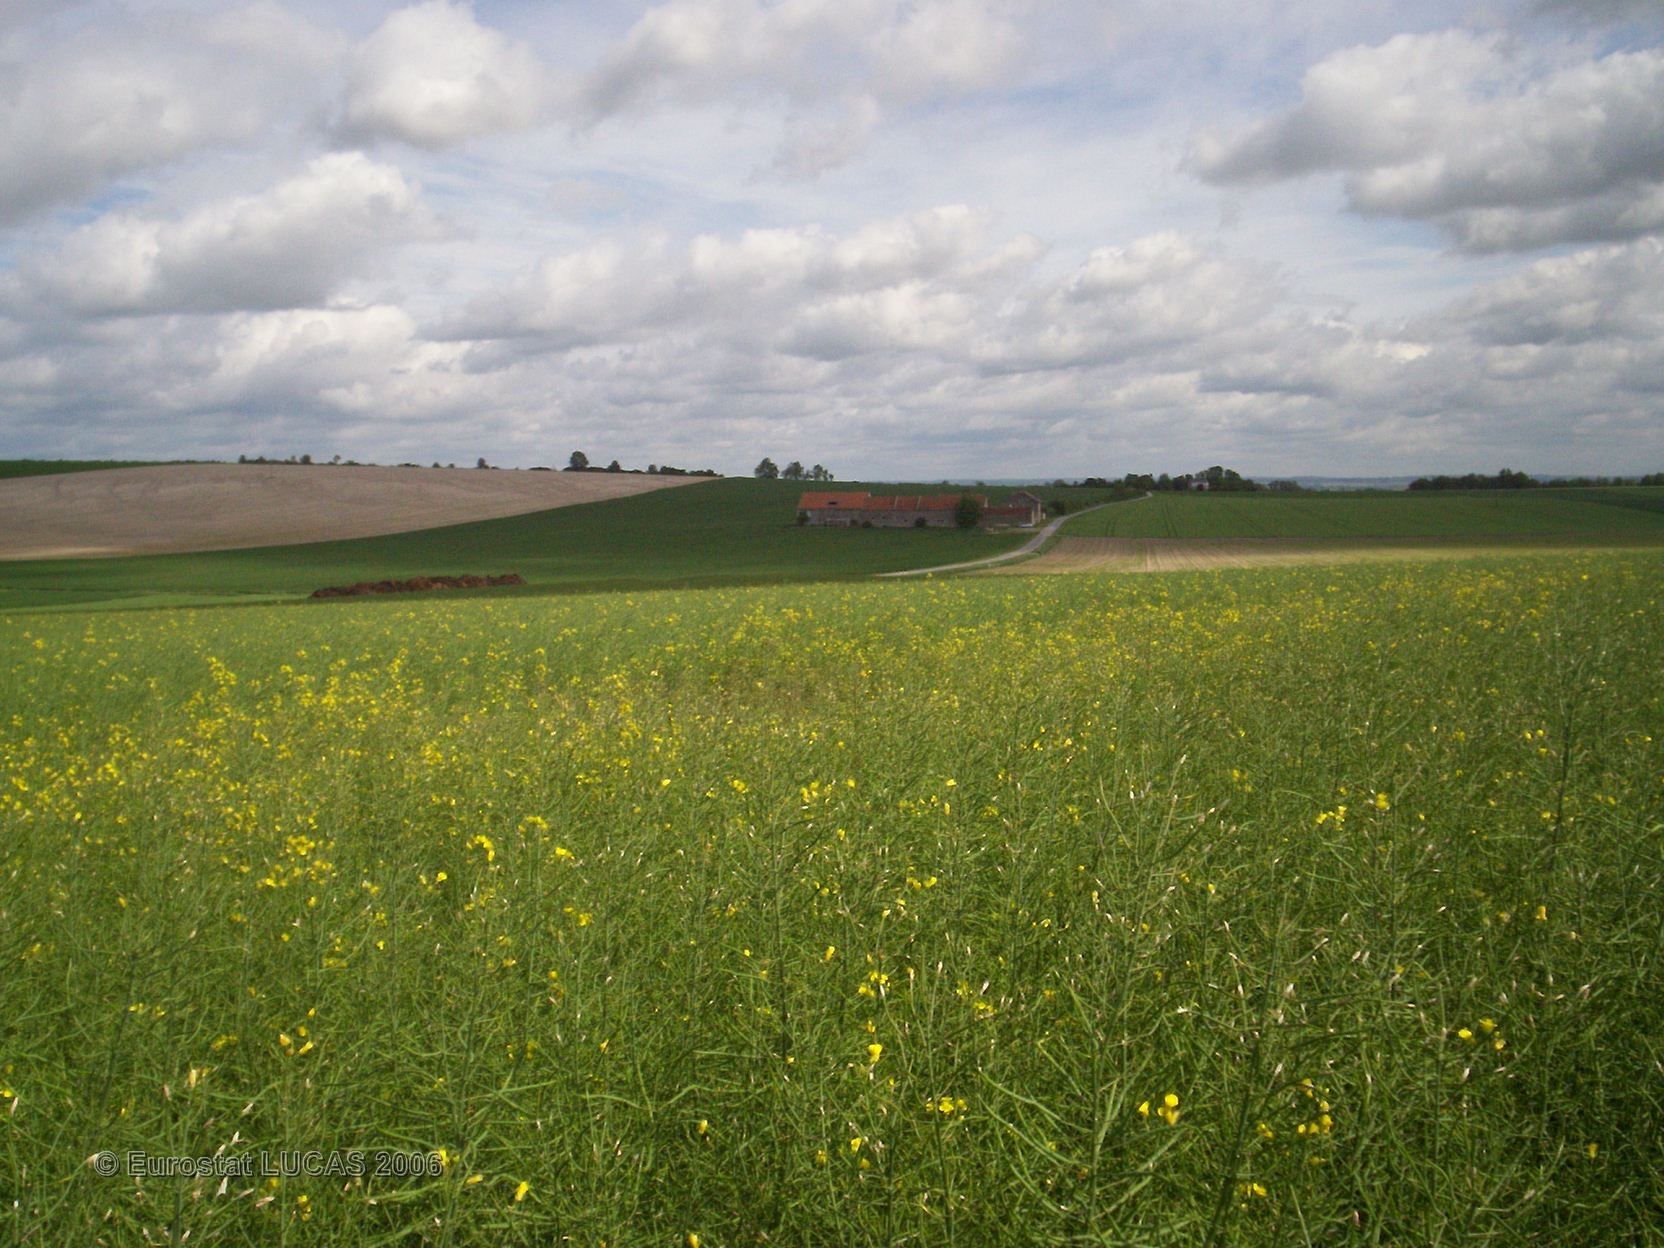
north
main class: Cropland
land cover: Rape and turnip rape
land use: Agriculture (excluding fallow land and kitchen gardens)
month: May
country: FR
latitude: 49.4715
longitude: 4.4347
